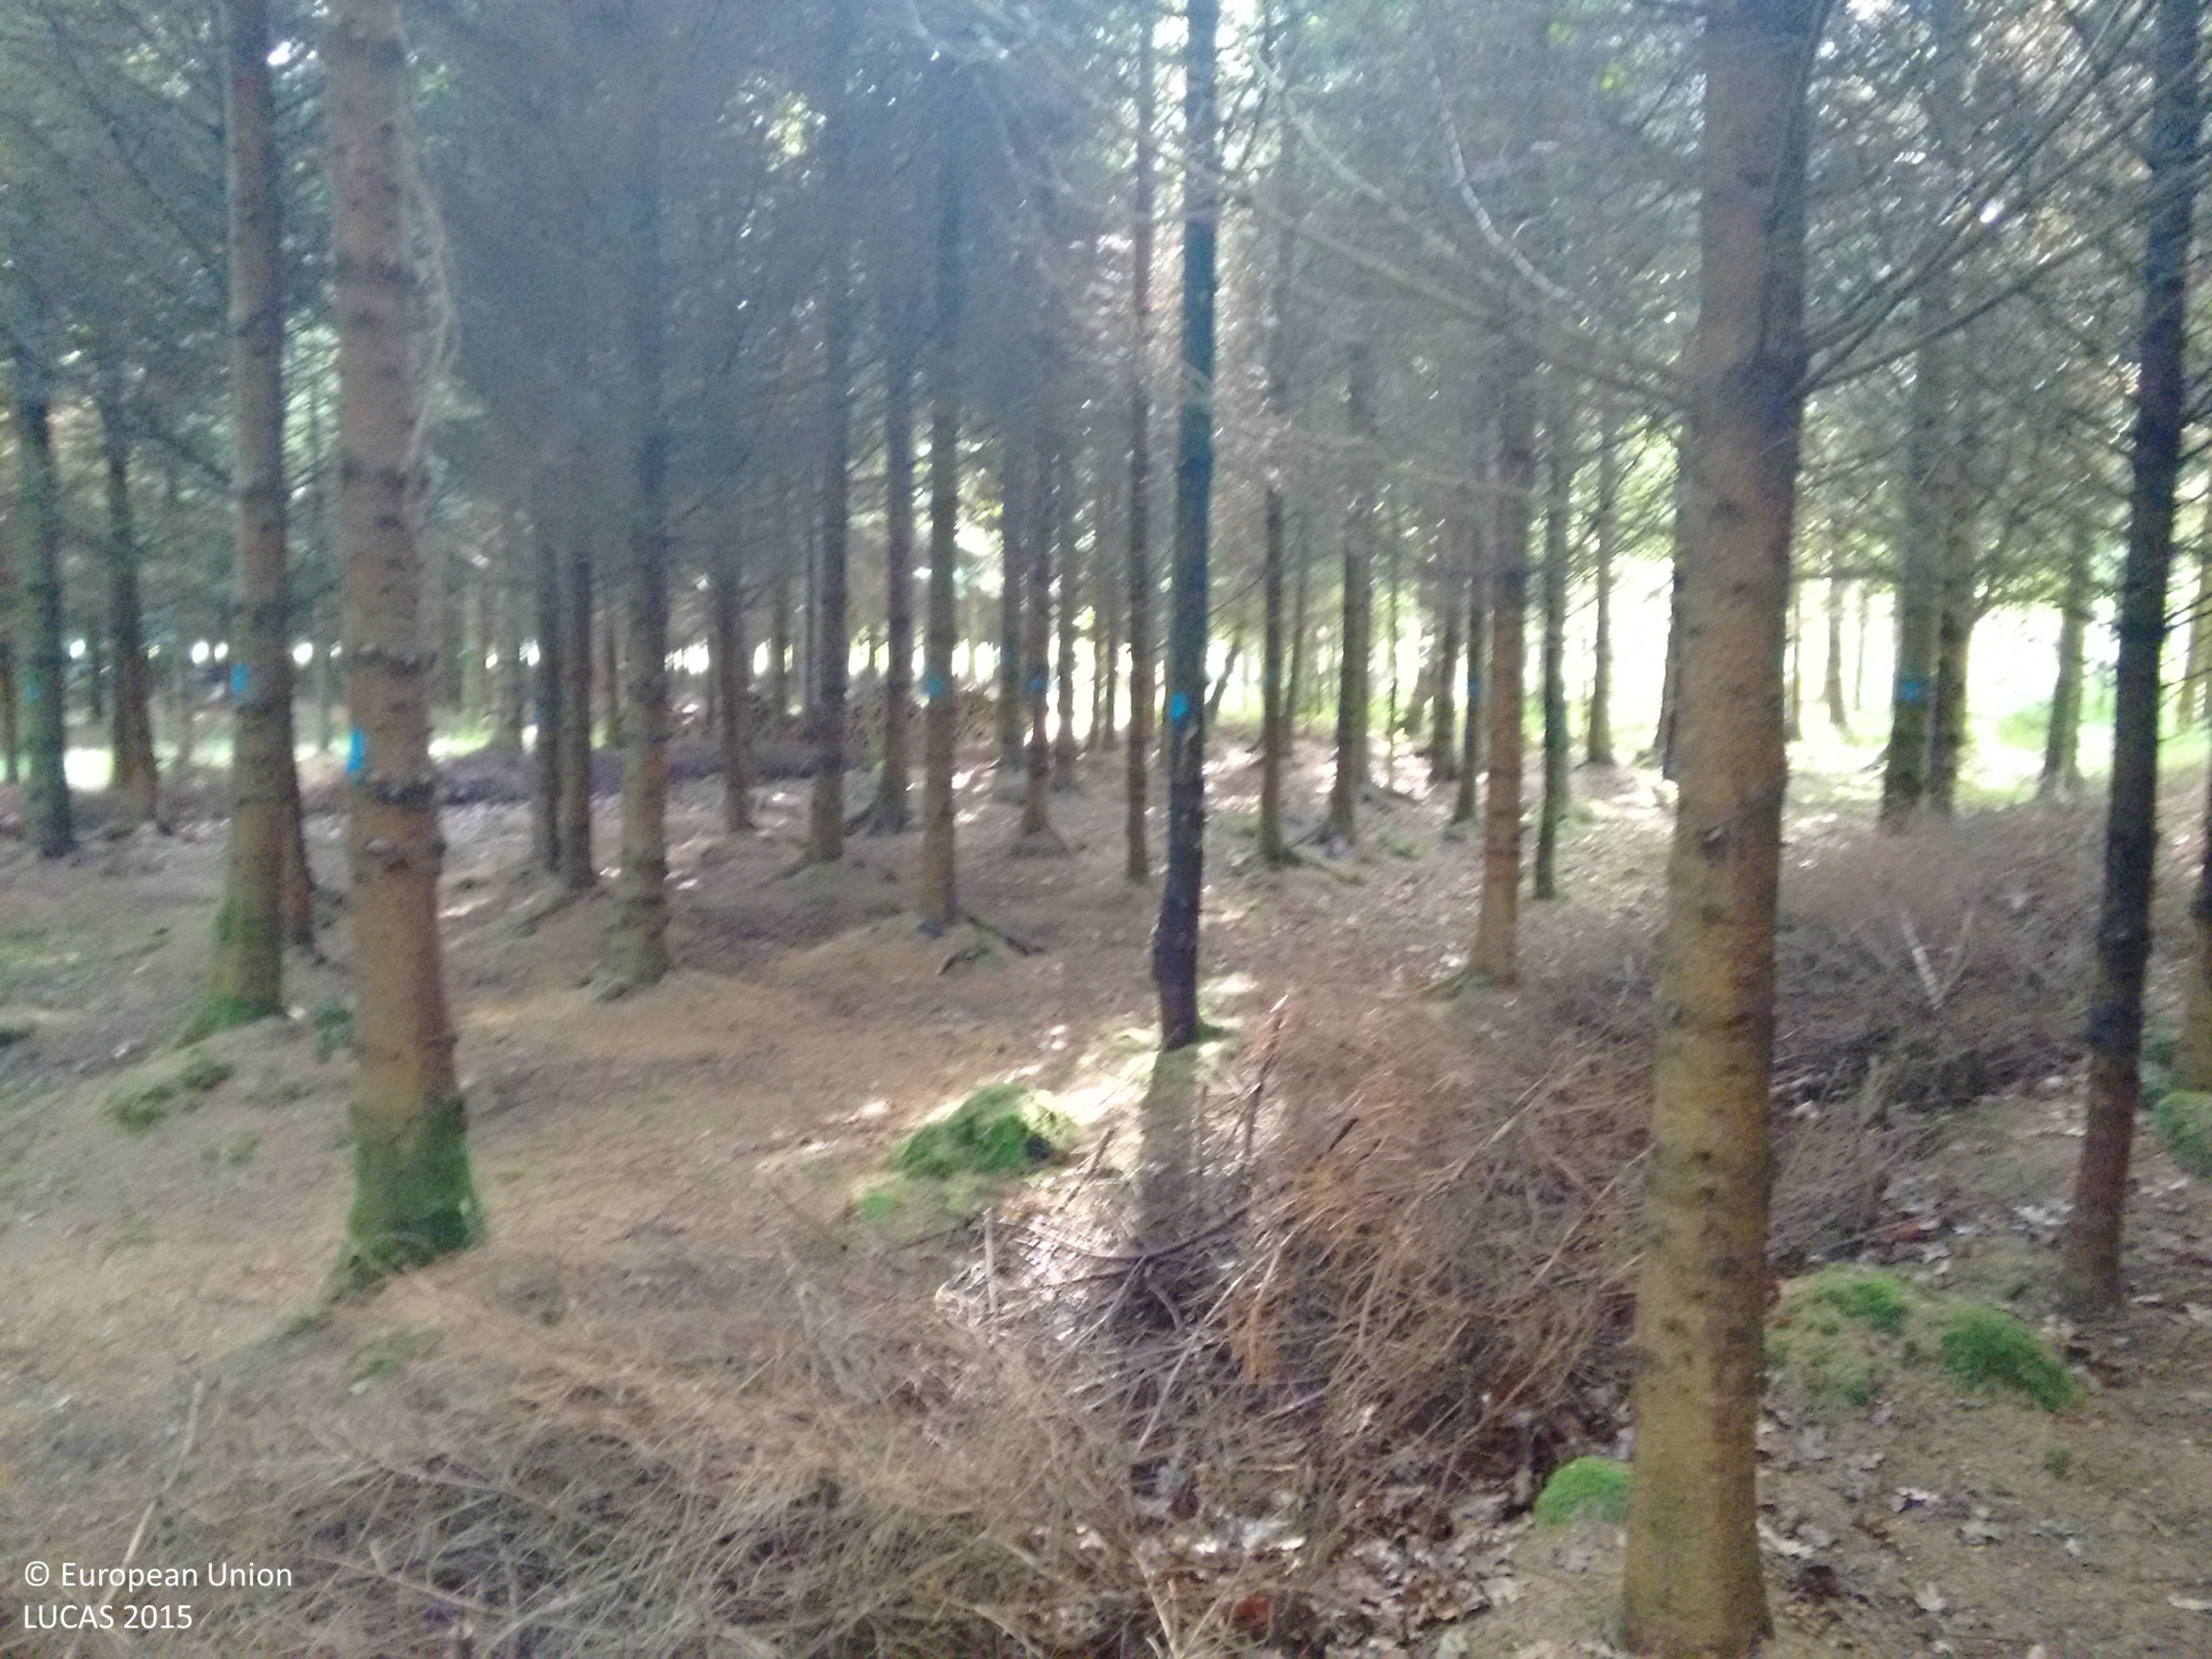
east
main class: Woodland
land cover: Spruce dominated coniferous woodland
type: exotic forest
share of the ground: > 75 %
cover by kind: coniferous forest trees 95 %, lichens and mosses 5 %
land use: Forestry
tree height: > 5 m
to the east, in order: Spruce dominated coniferous woodland; Ditches and canals; Spruce dominated coniferous woodland; Ditches and canals; Tracks; Spruce dominated coniferous woodland; Grassland without tree/shrub cover; Electric lines; Grassland without tree/shrub cover; Artificial constructions in urban areas
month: June
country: IE
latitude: 52.2816
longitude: -7.1058
